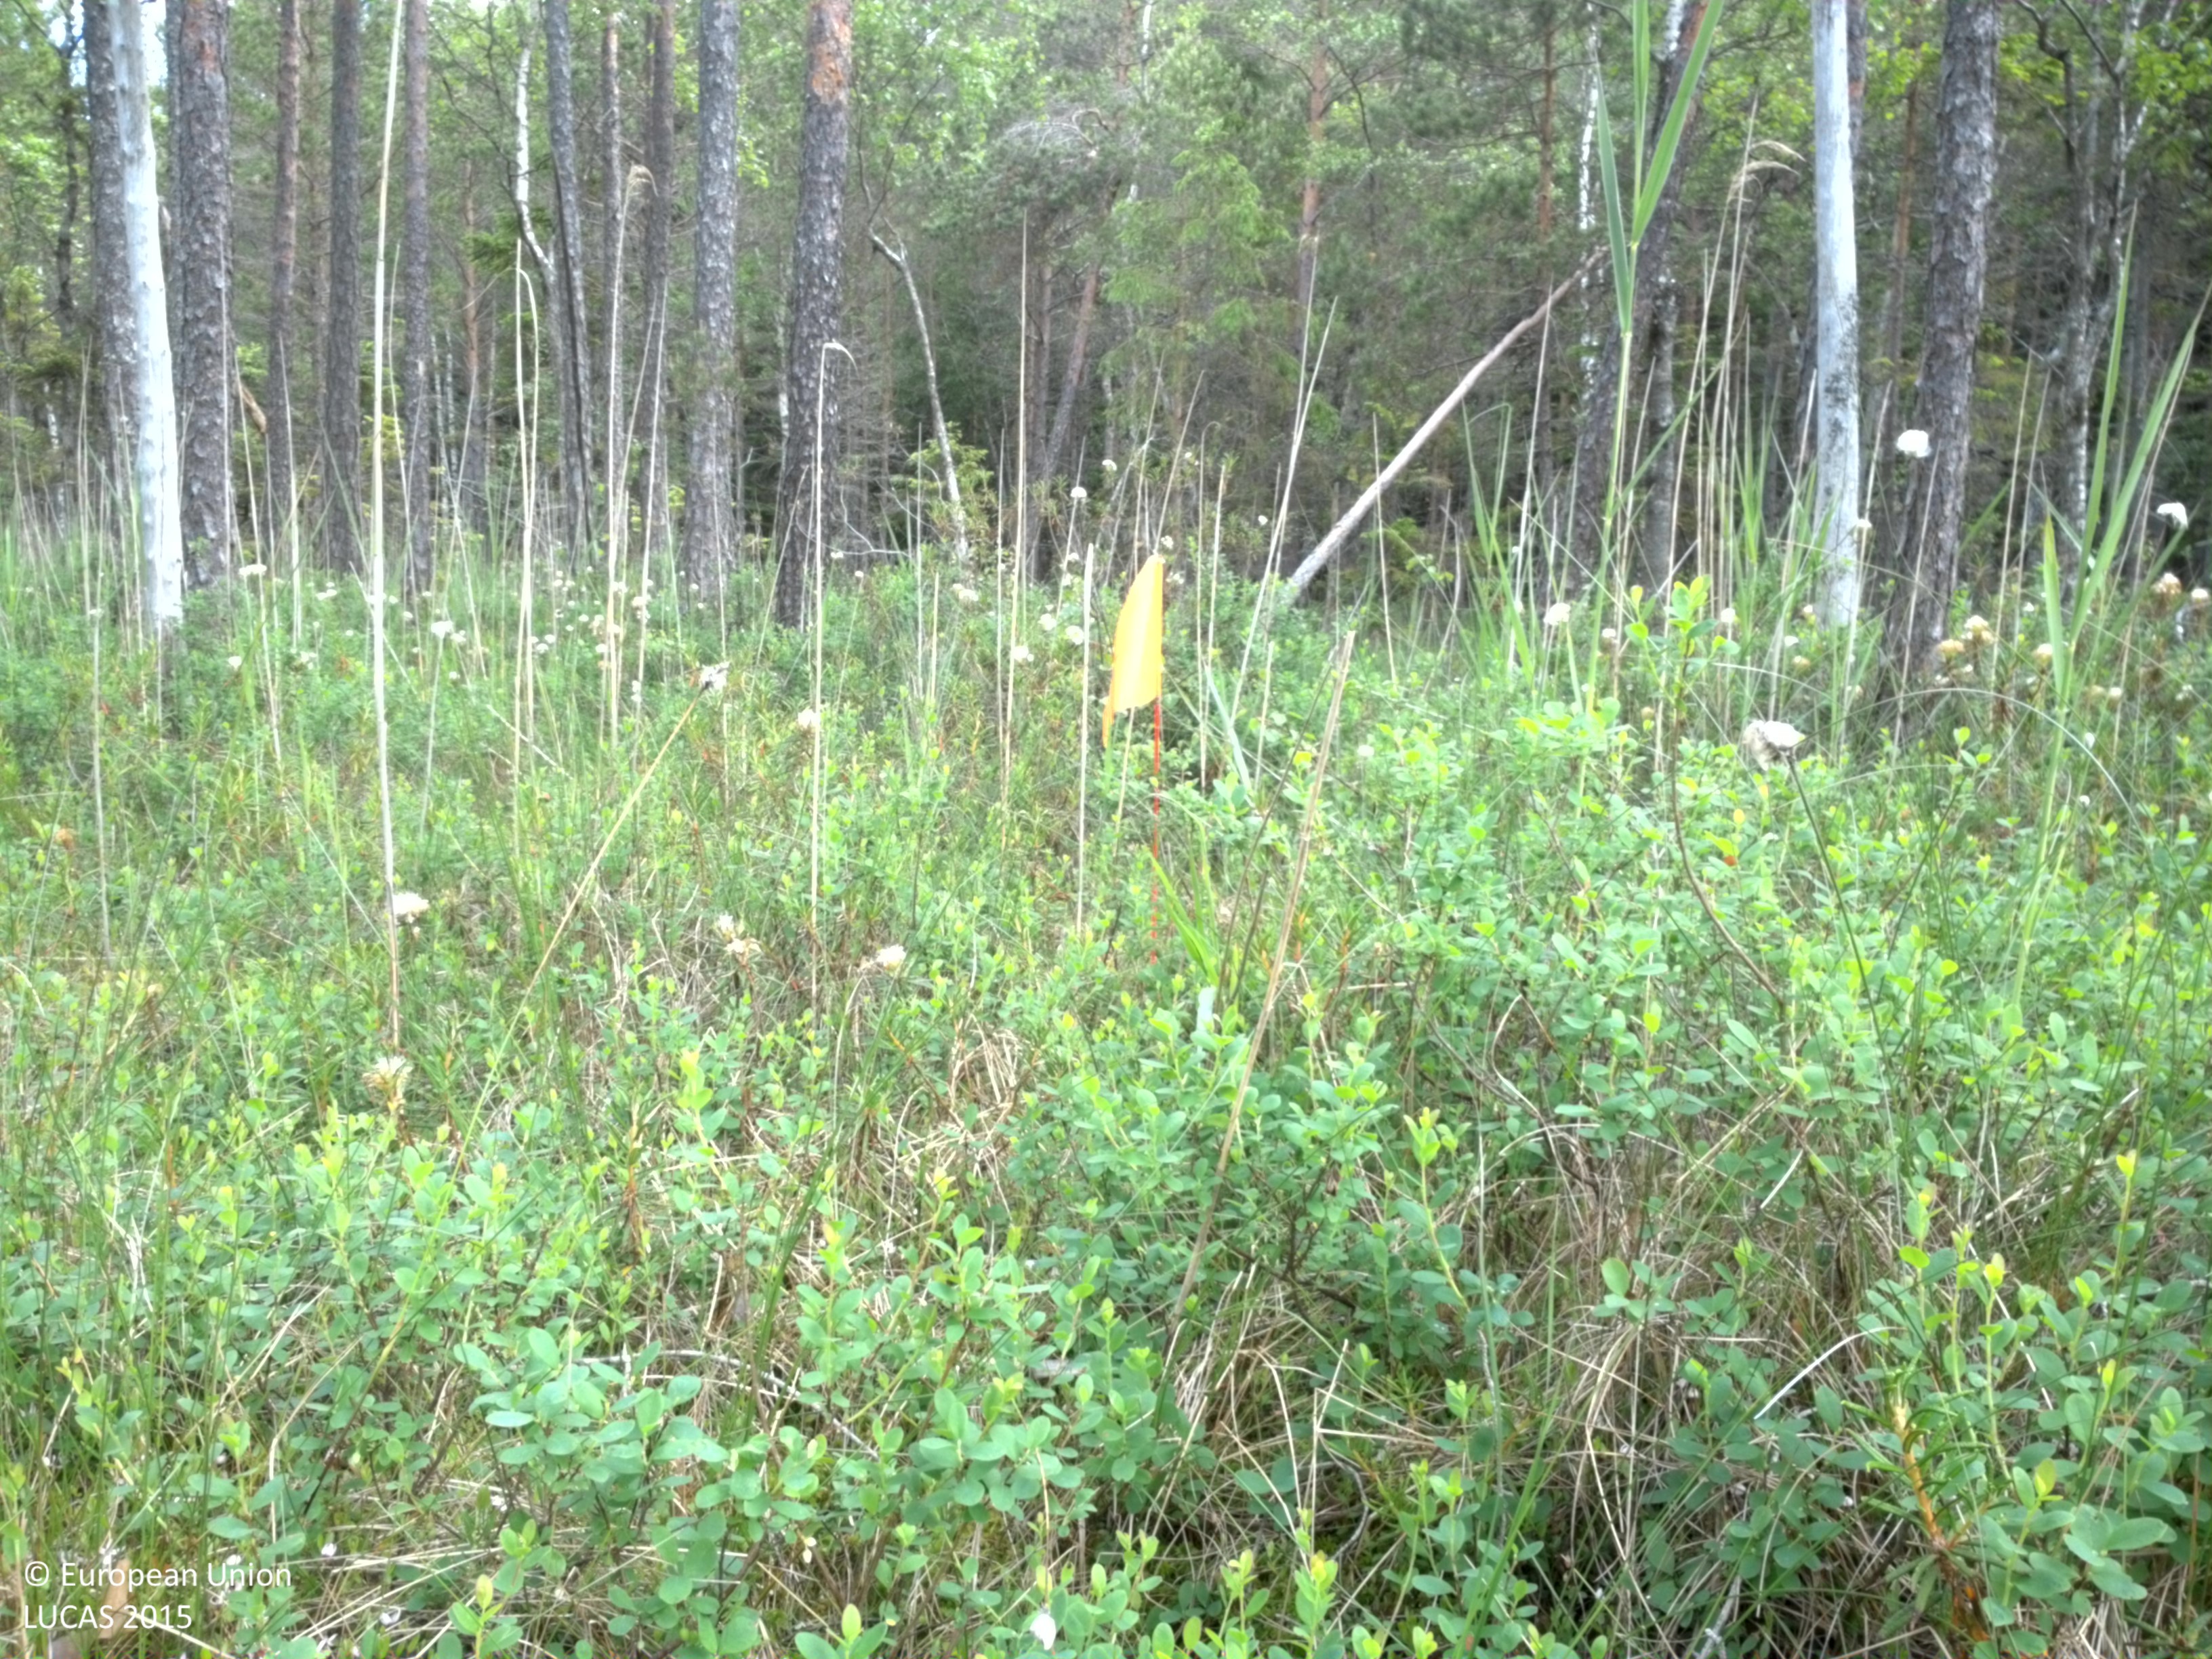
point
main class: Woodland
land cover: Pine dominated coniferous woodland
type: boreal forest
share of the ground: 25 - 50 %
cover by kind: coniferous forest trees 45 %, herbaceous plants 25 %, lichens and mosses 25 %, broadleaved forest trees 5 %
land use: Forestry
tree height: > 5 m
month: June
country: SE
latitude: 59.9458
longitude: 17.1348
